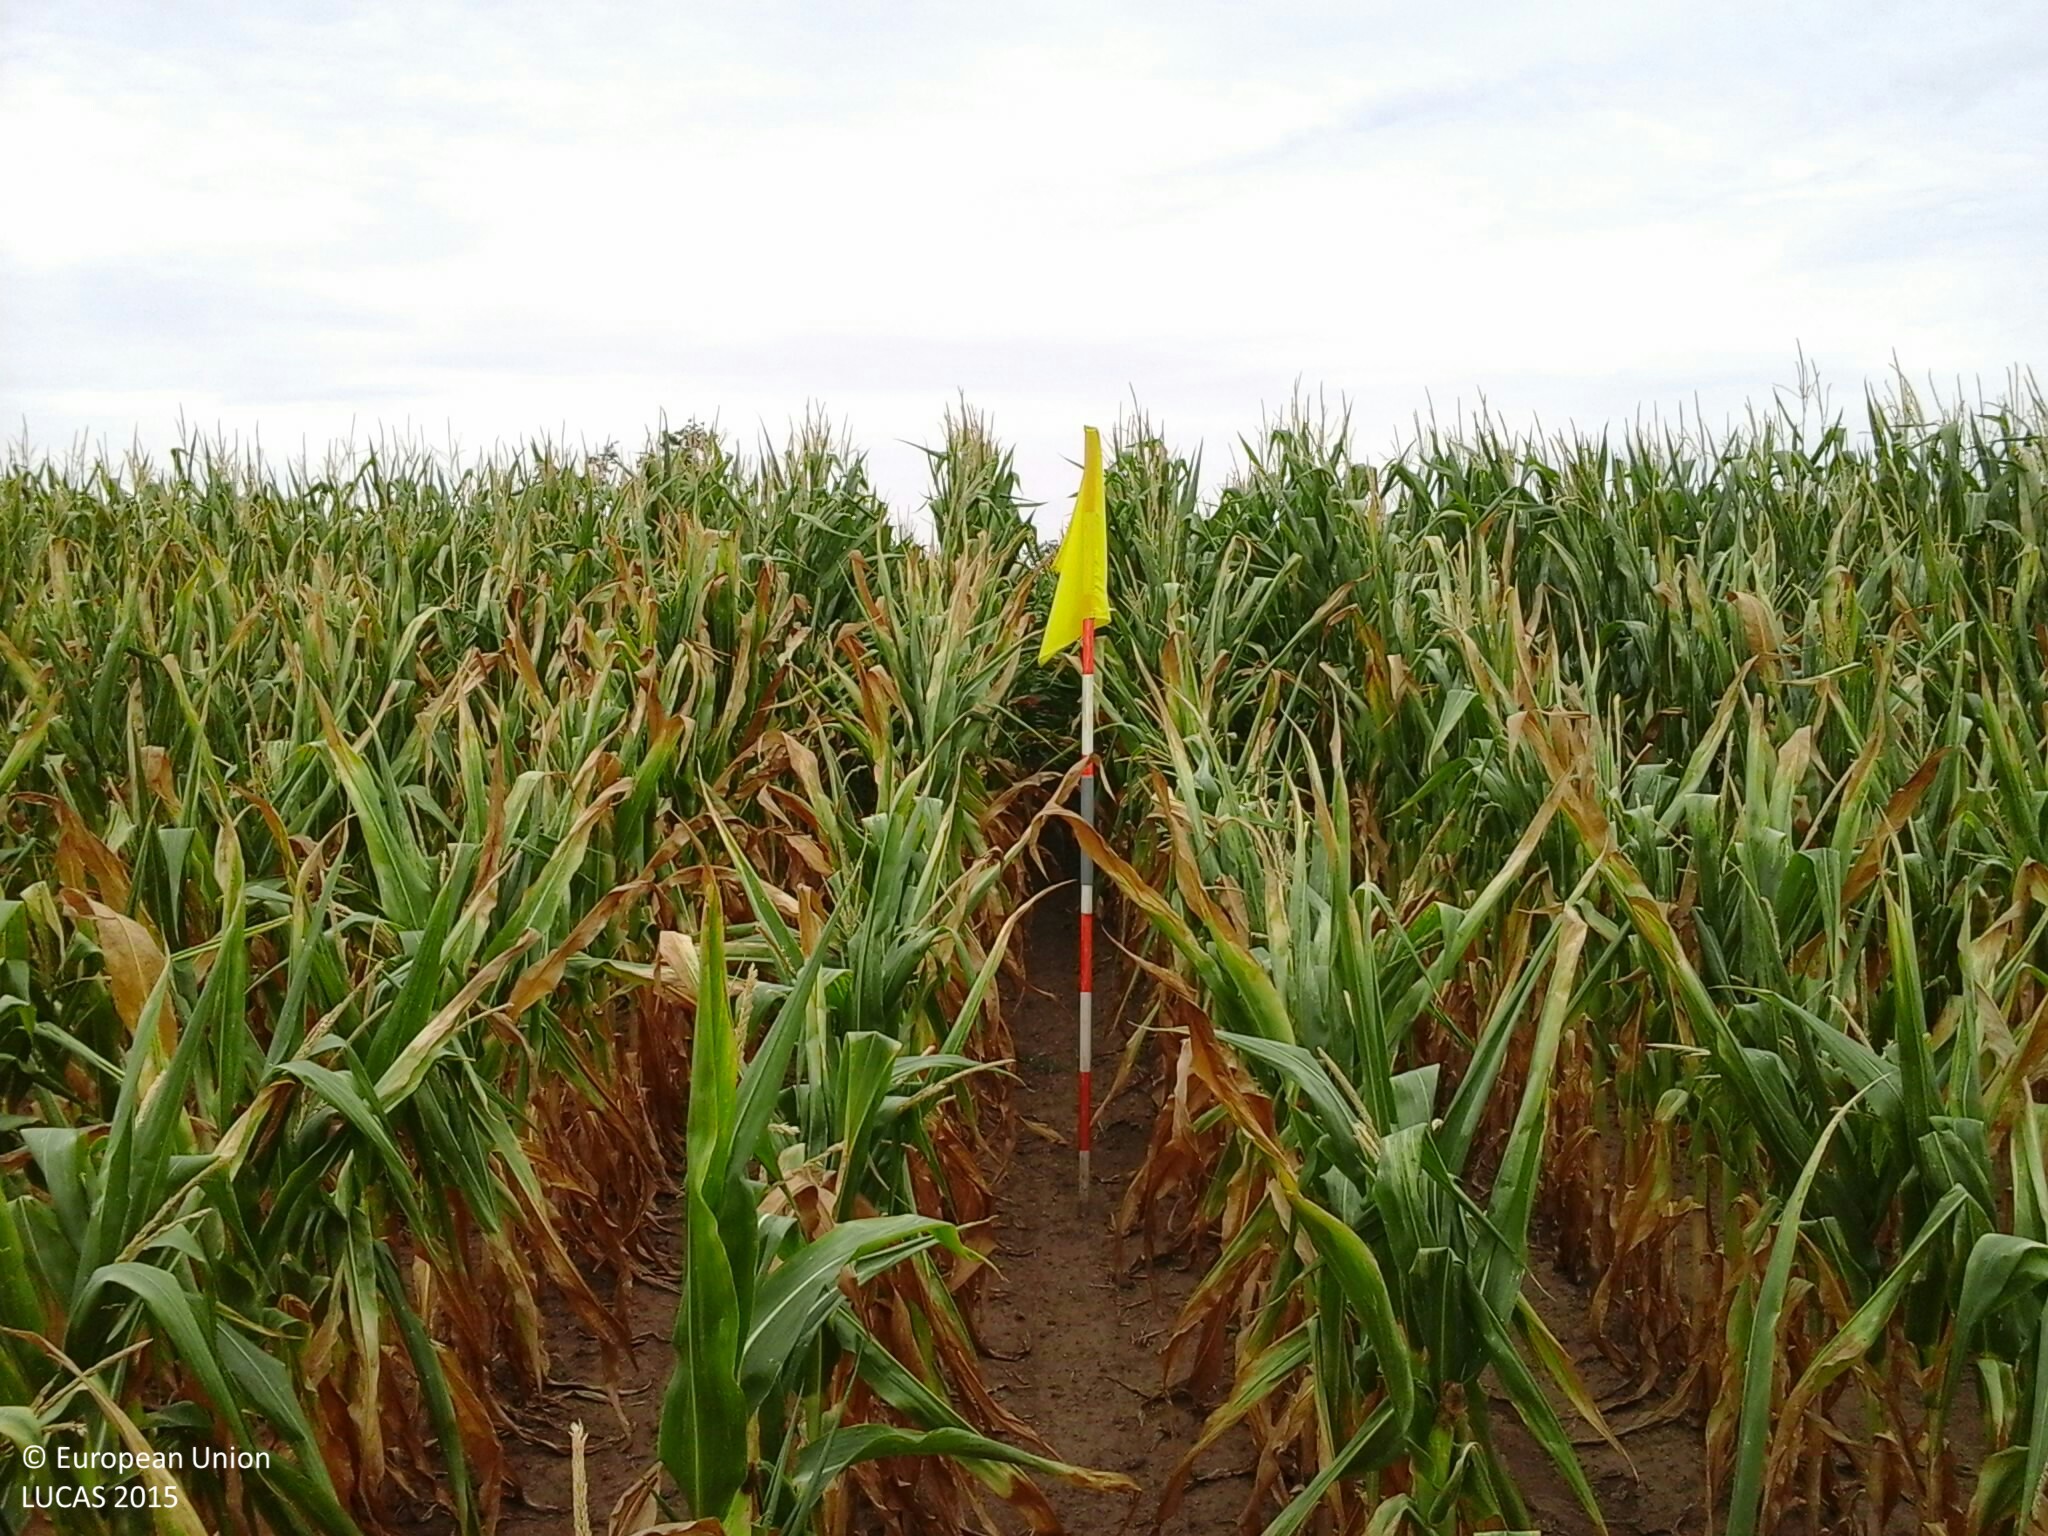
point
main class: Cropland
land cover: Maize
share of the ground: > 75 %
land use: Agriculture (excluding fallow land and kitchen gardens)
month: July
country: HU
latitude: 47.8792
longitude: 21.4498
